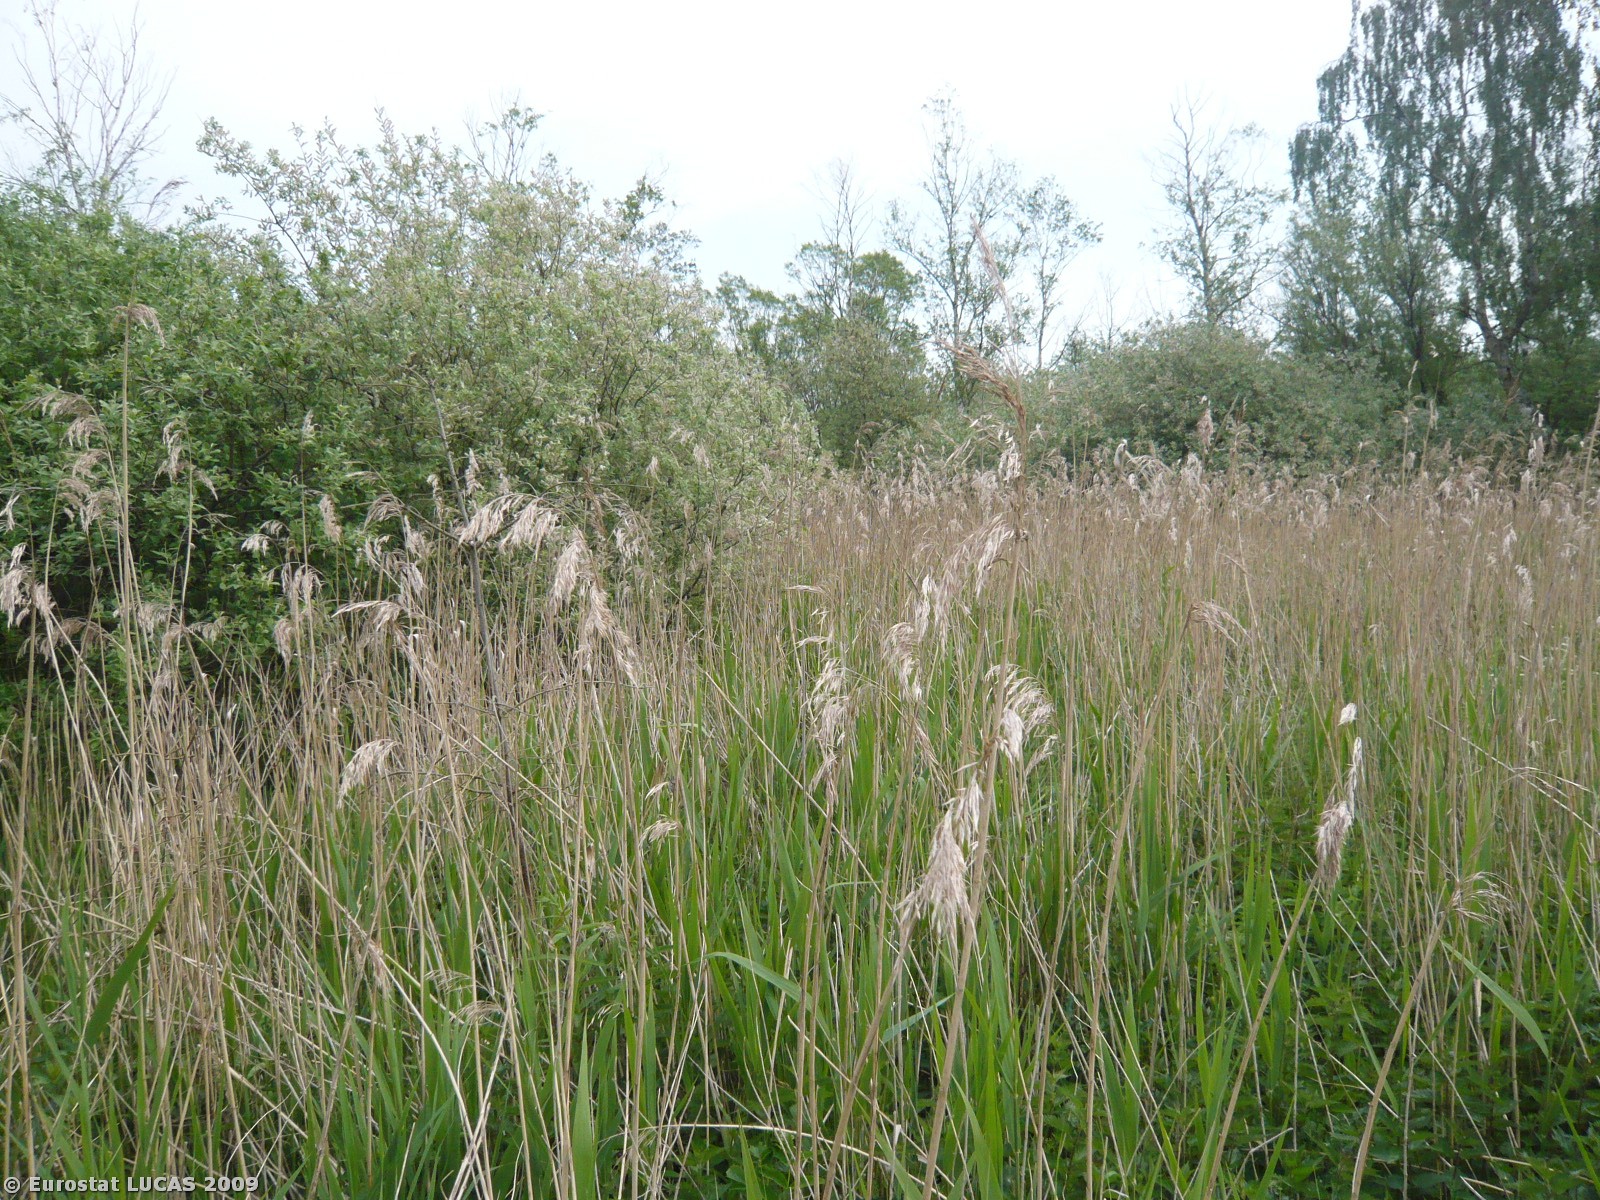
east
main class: Wetlands
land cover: Inland marshes
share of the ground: > 75 %
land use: Unused
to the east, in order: Inland marshes; Inland water bodies; Broadleaved woodland; Grassland without tree/shrub cover; Barley
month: May
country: DK
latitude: 55.2217
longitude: 11.8378
